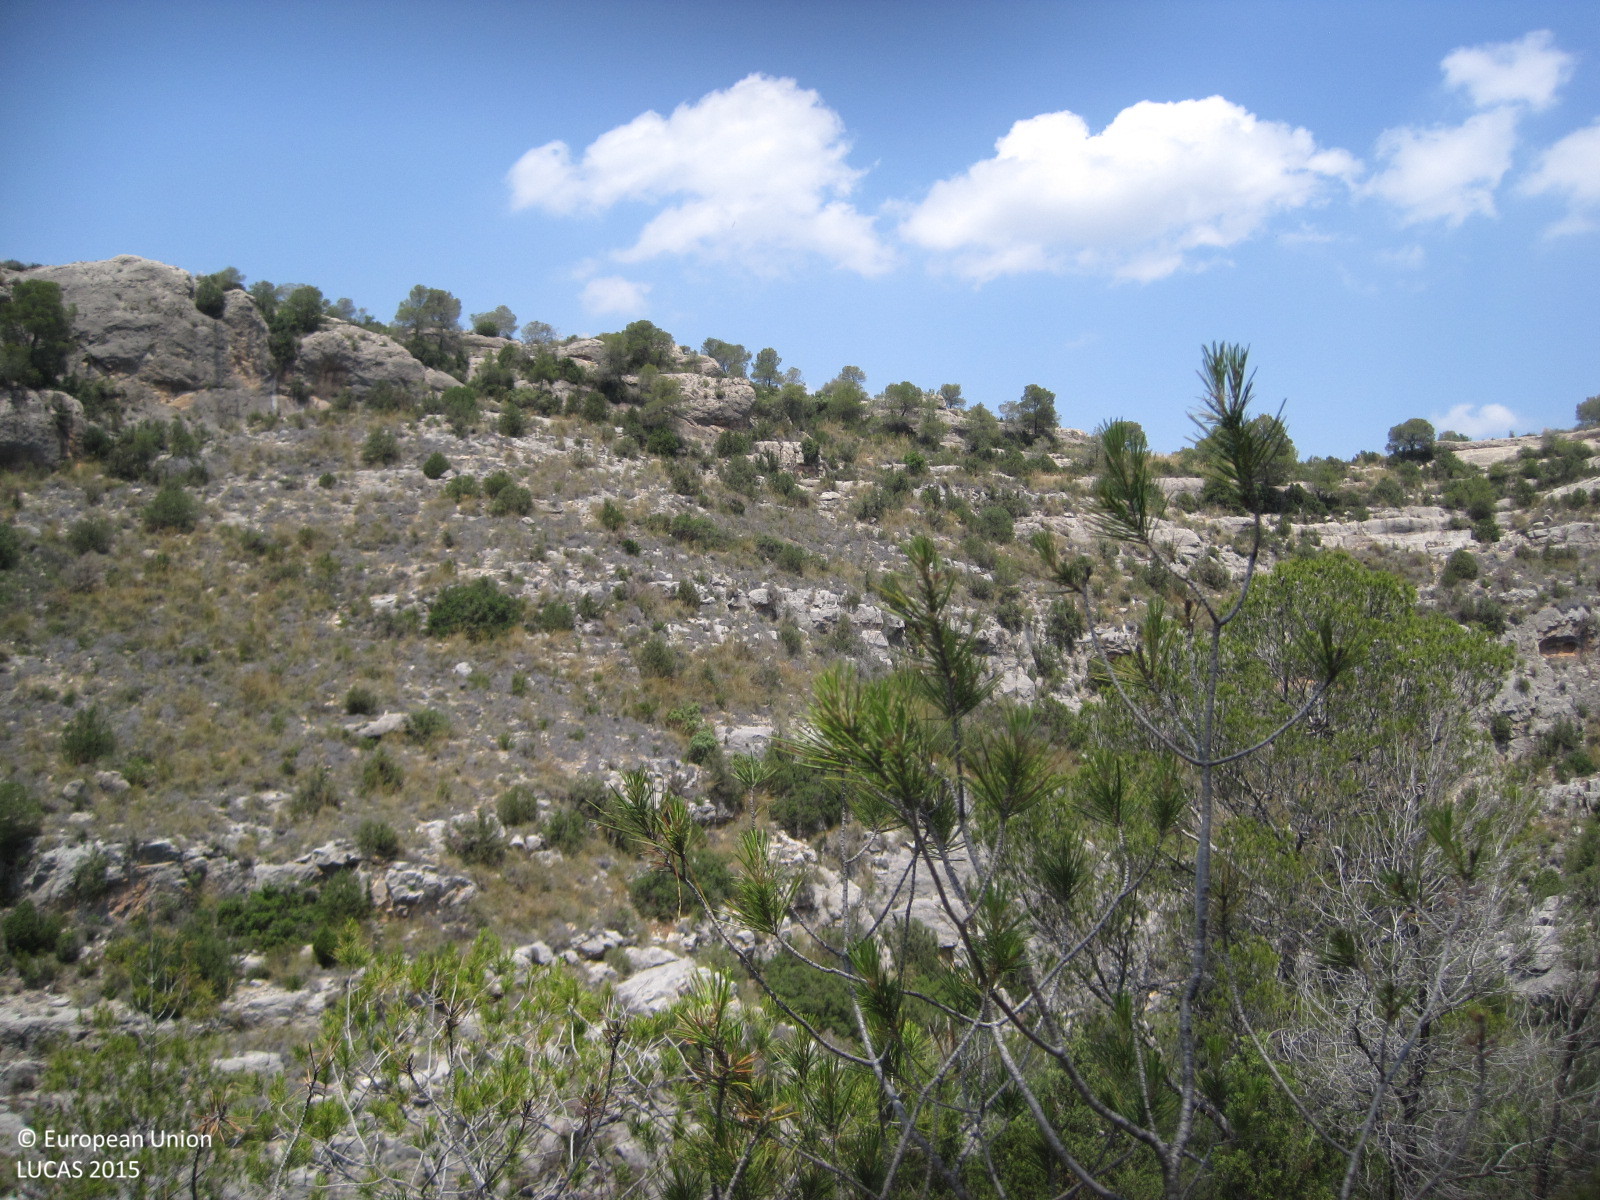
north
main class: Woodland
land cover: Pine dominated coniferous woodland
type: coniferous forest of the mediterranean region
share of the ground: 25 - 50 %
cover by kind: shrubs 45 %, coniferous forest trees 30 %, herbaceous plants 20 %, consolidated bare surface 5 %
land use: Forestry
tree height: > 5 m
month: June
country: ES
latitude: 39.7425
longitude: -0.9610
